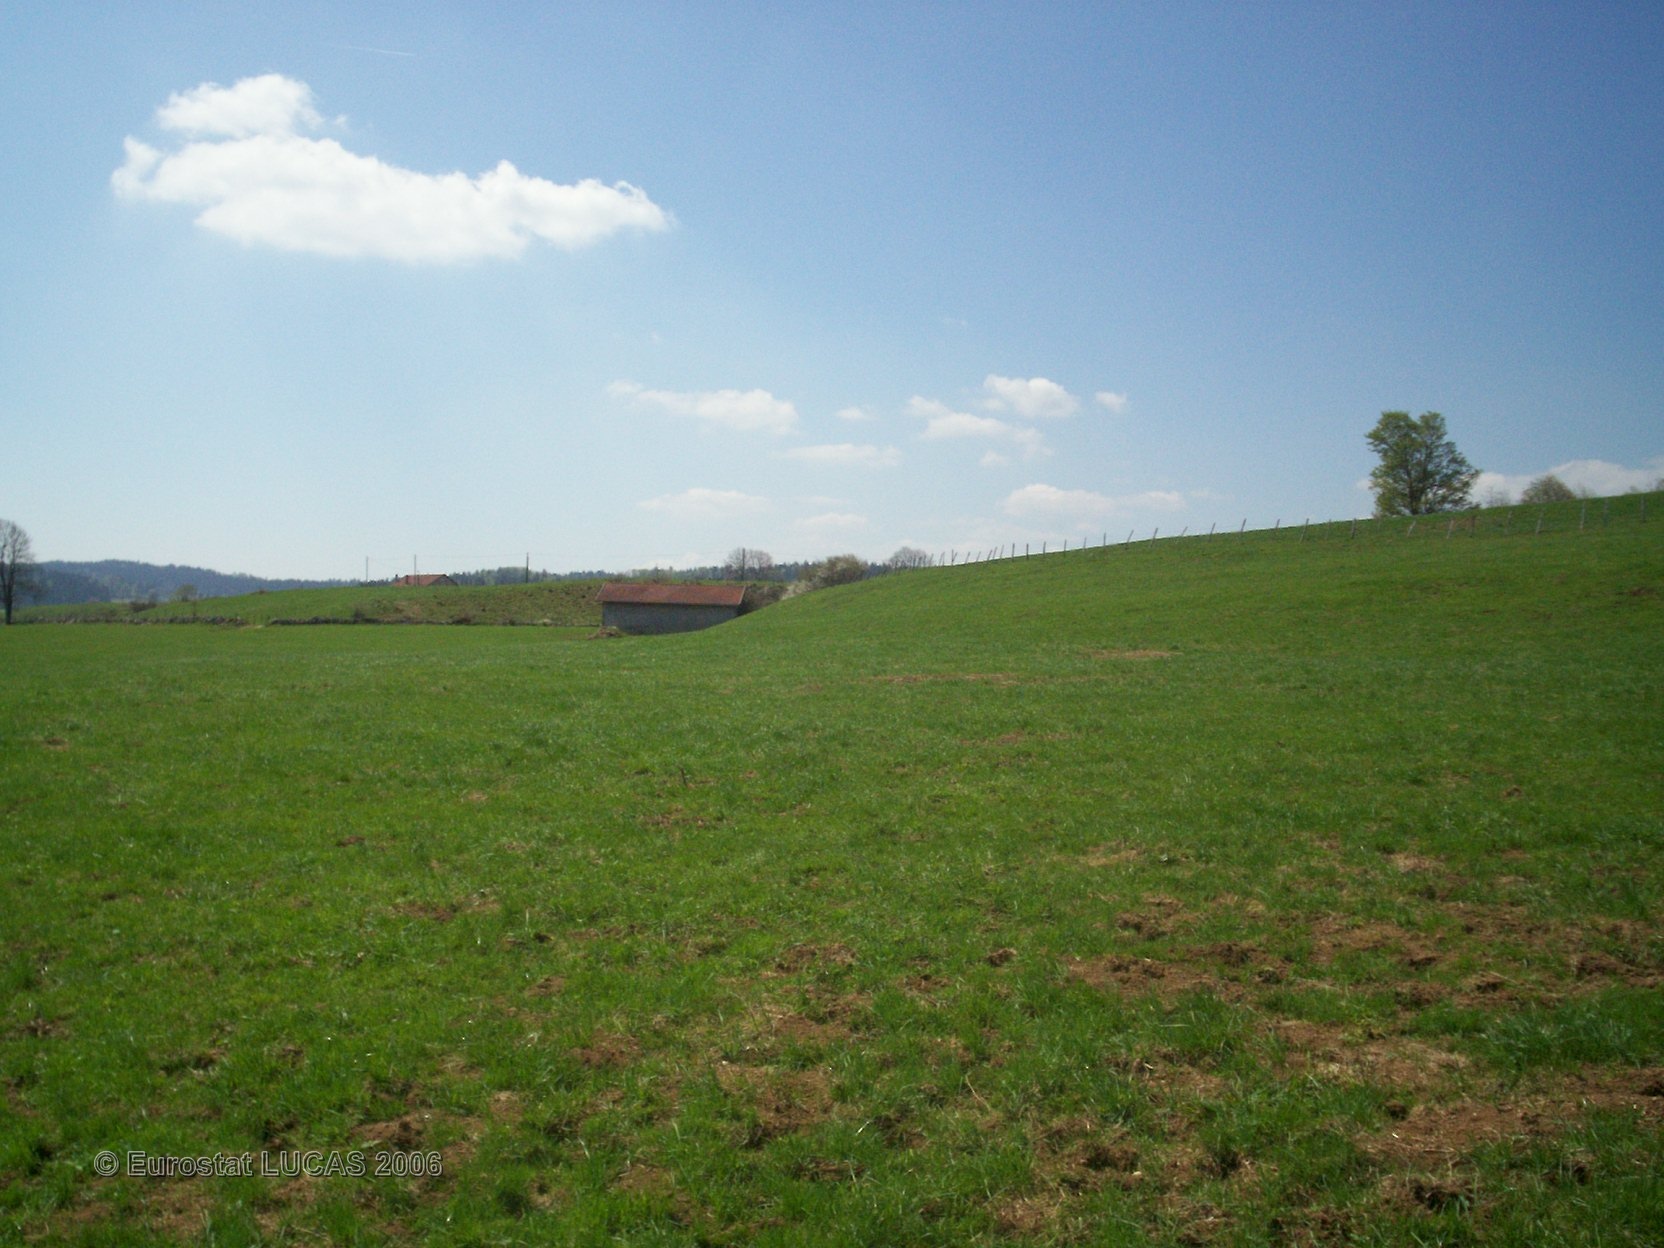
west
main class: Grassland
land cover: Grassland without tree/shrub cover
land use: Agriculture (excluding fallow land and kitchen gardens)
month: May
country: FR
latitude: 47.1096
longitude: 6.6418
